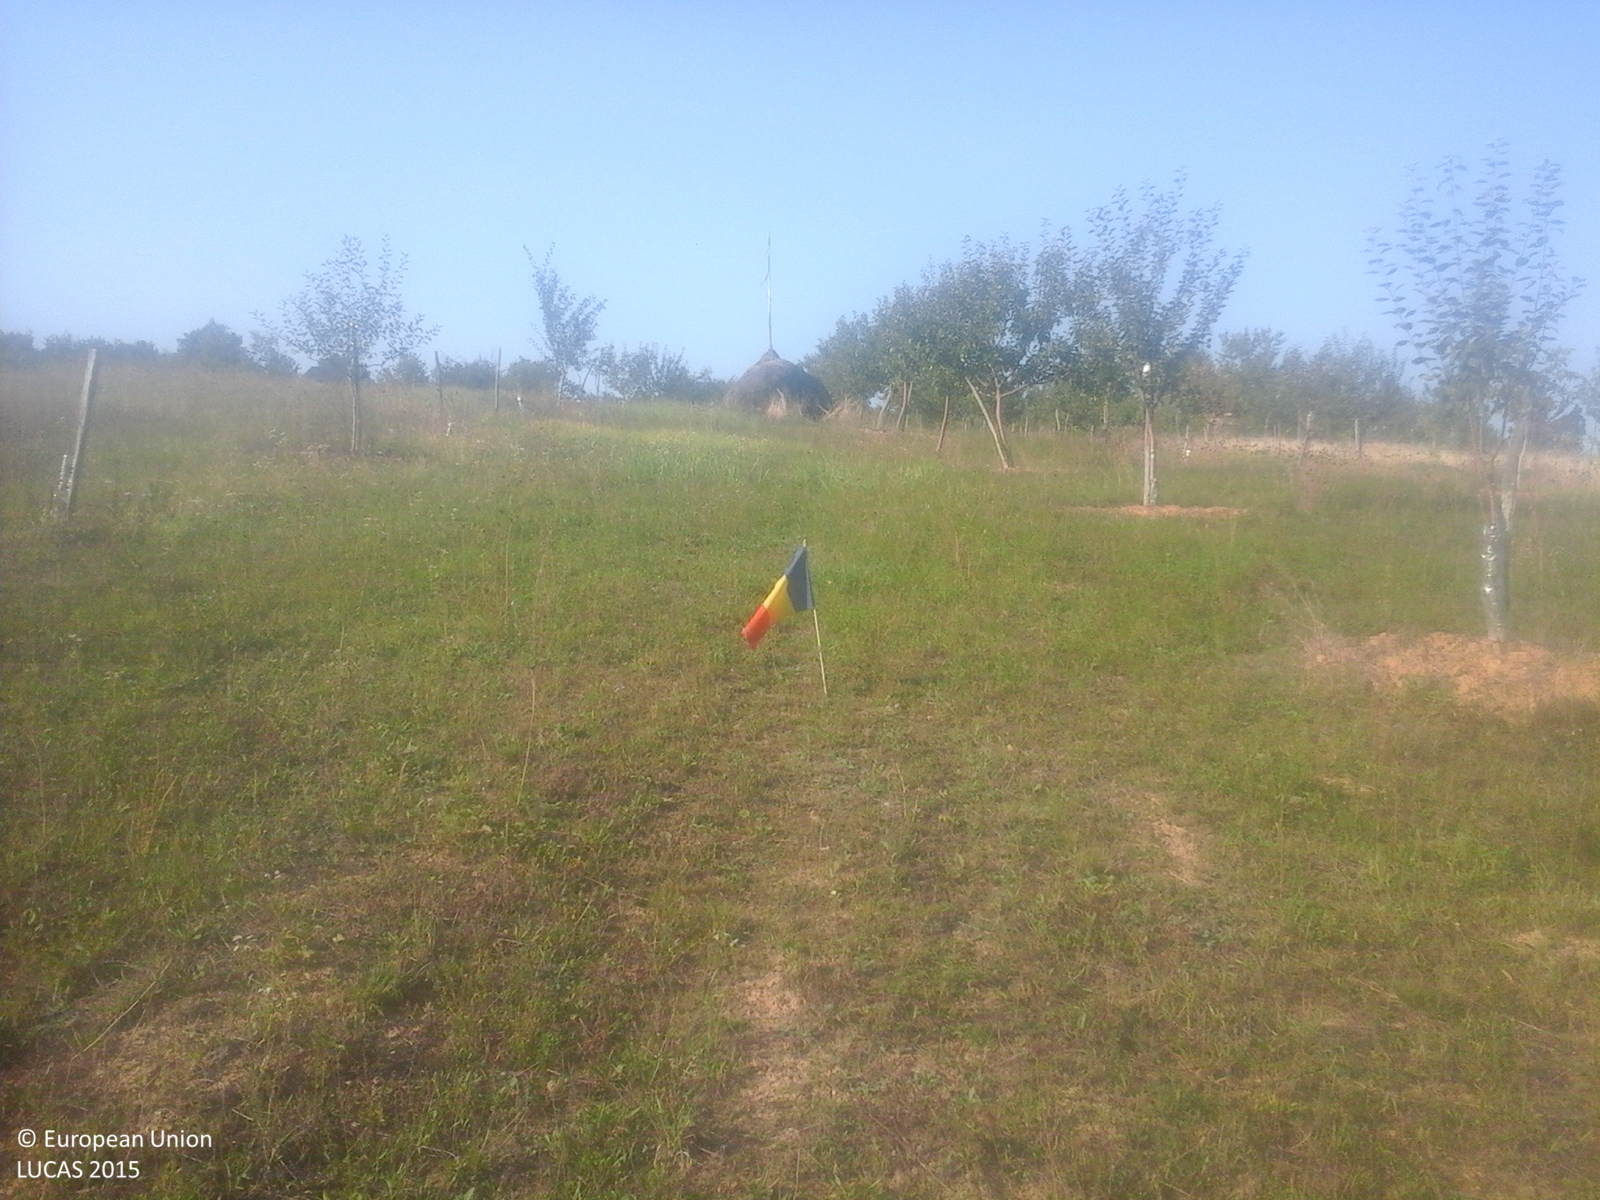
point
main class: Cropland
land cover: Apple fruit
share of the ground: 10 - 25 %
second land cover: Grassland without tree/shrub cover
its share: > 75 %
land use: Agriculture (excluding fallow land and kitchen gardens)
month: September
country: RO
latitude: 46.6172
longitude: 22.3376
